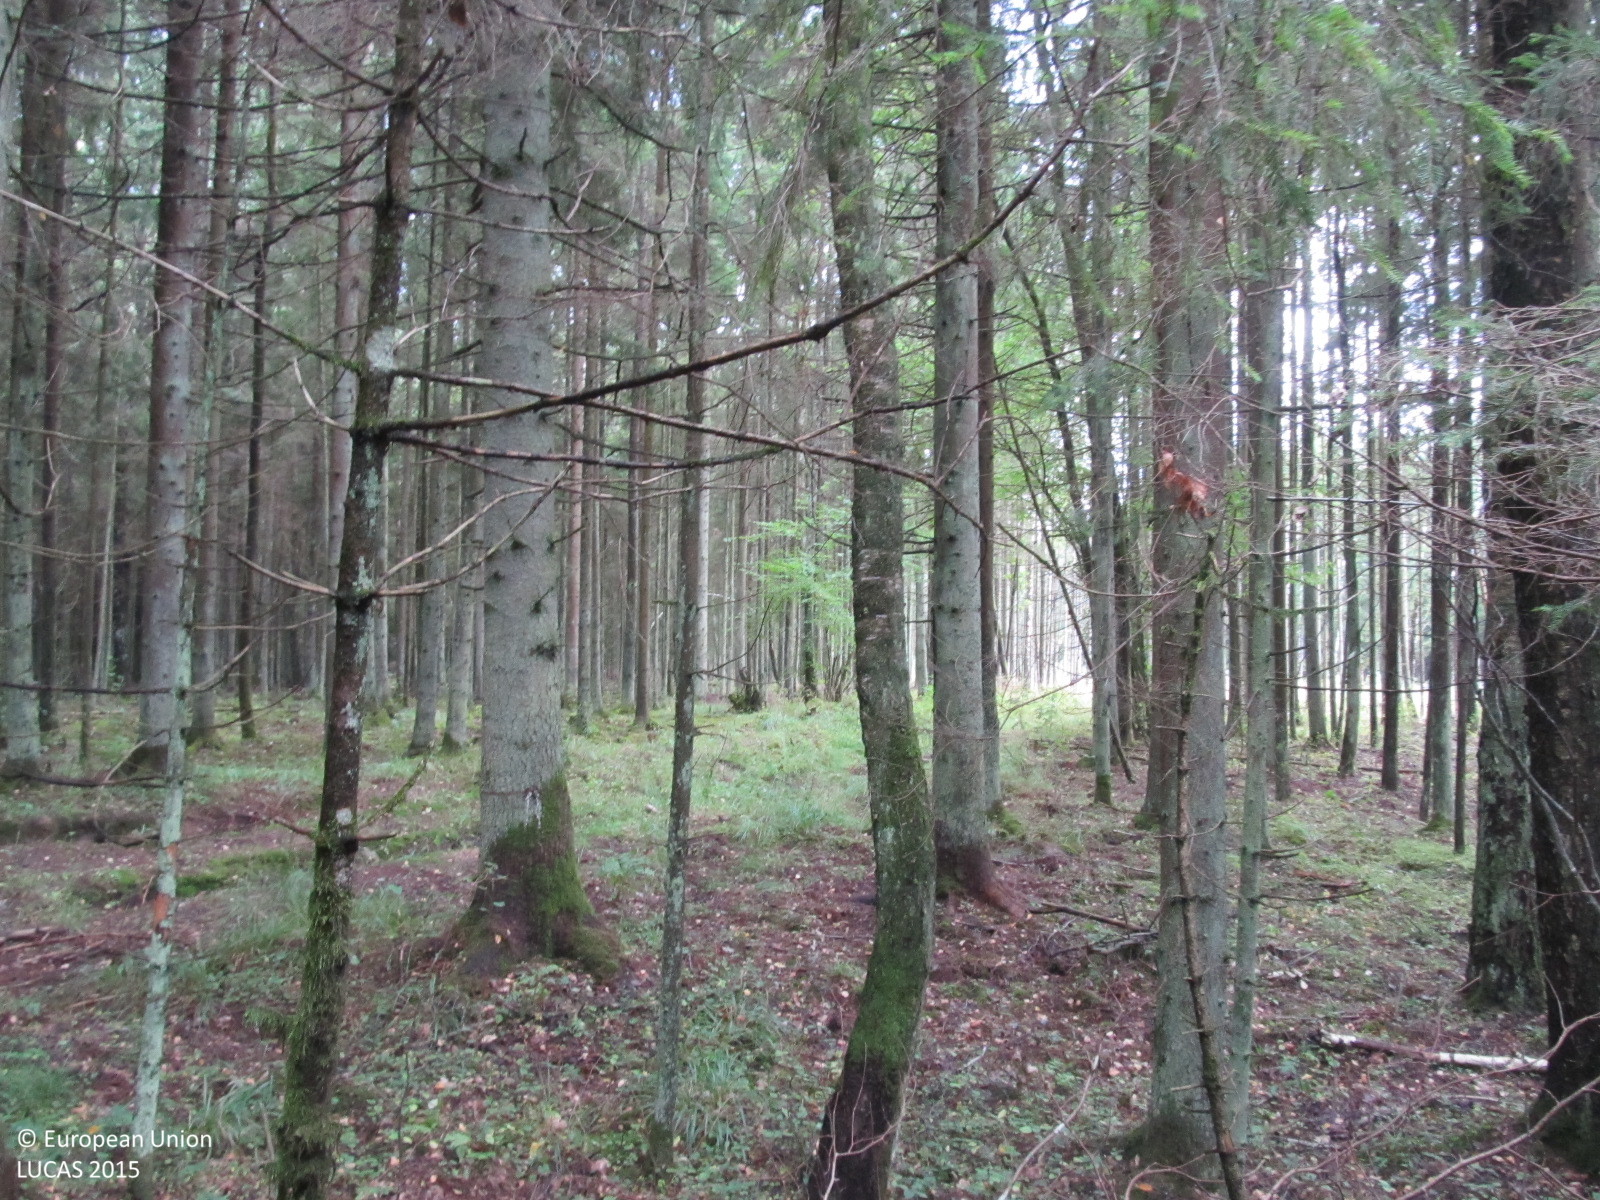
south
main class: Woodland
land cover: Spruce dominated mixed woodland
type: non-riverine alder, birch or aspen forest
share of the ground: > 75 %
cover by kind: coniferous forest trees 50 %, broadleaved forest trees 30 %, herbaceous plants 10 %, lichens and mosses 5 %, unconsolidated bare surface 5 %
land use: Forestry
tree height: > 5 m
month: September
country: LT
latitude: 55.9979
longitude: 22.8115
